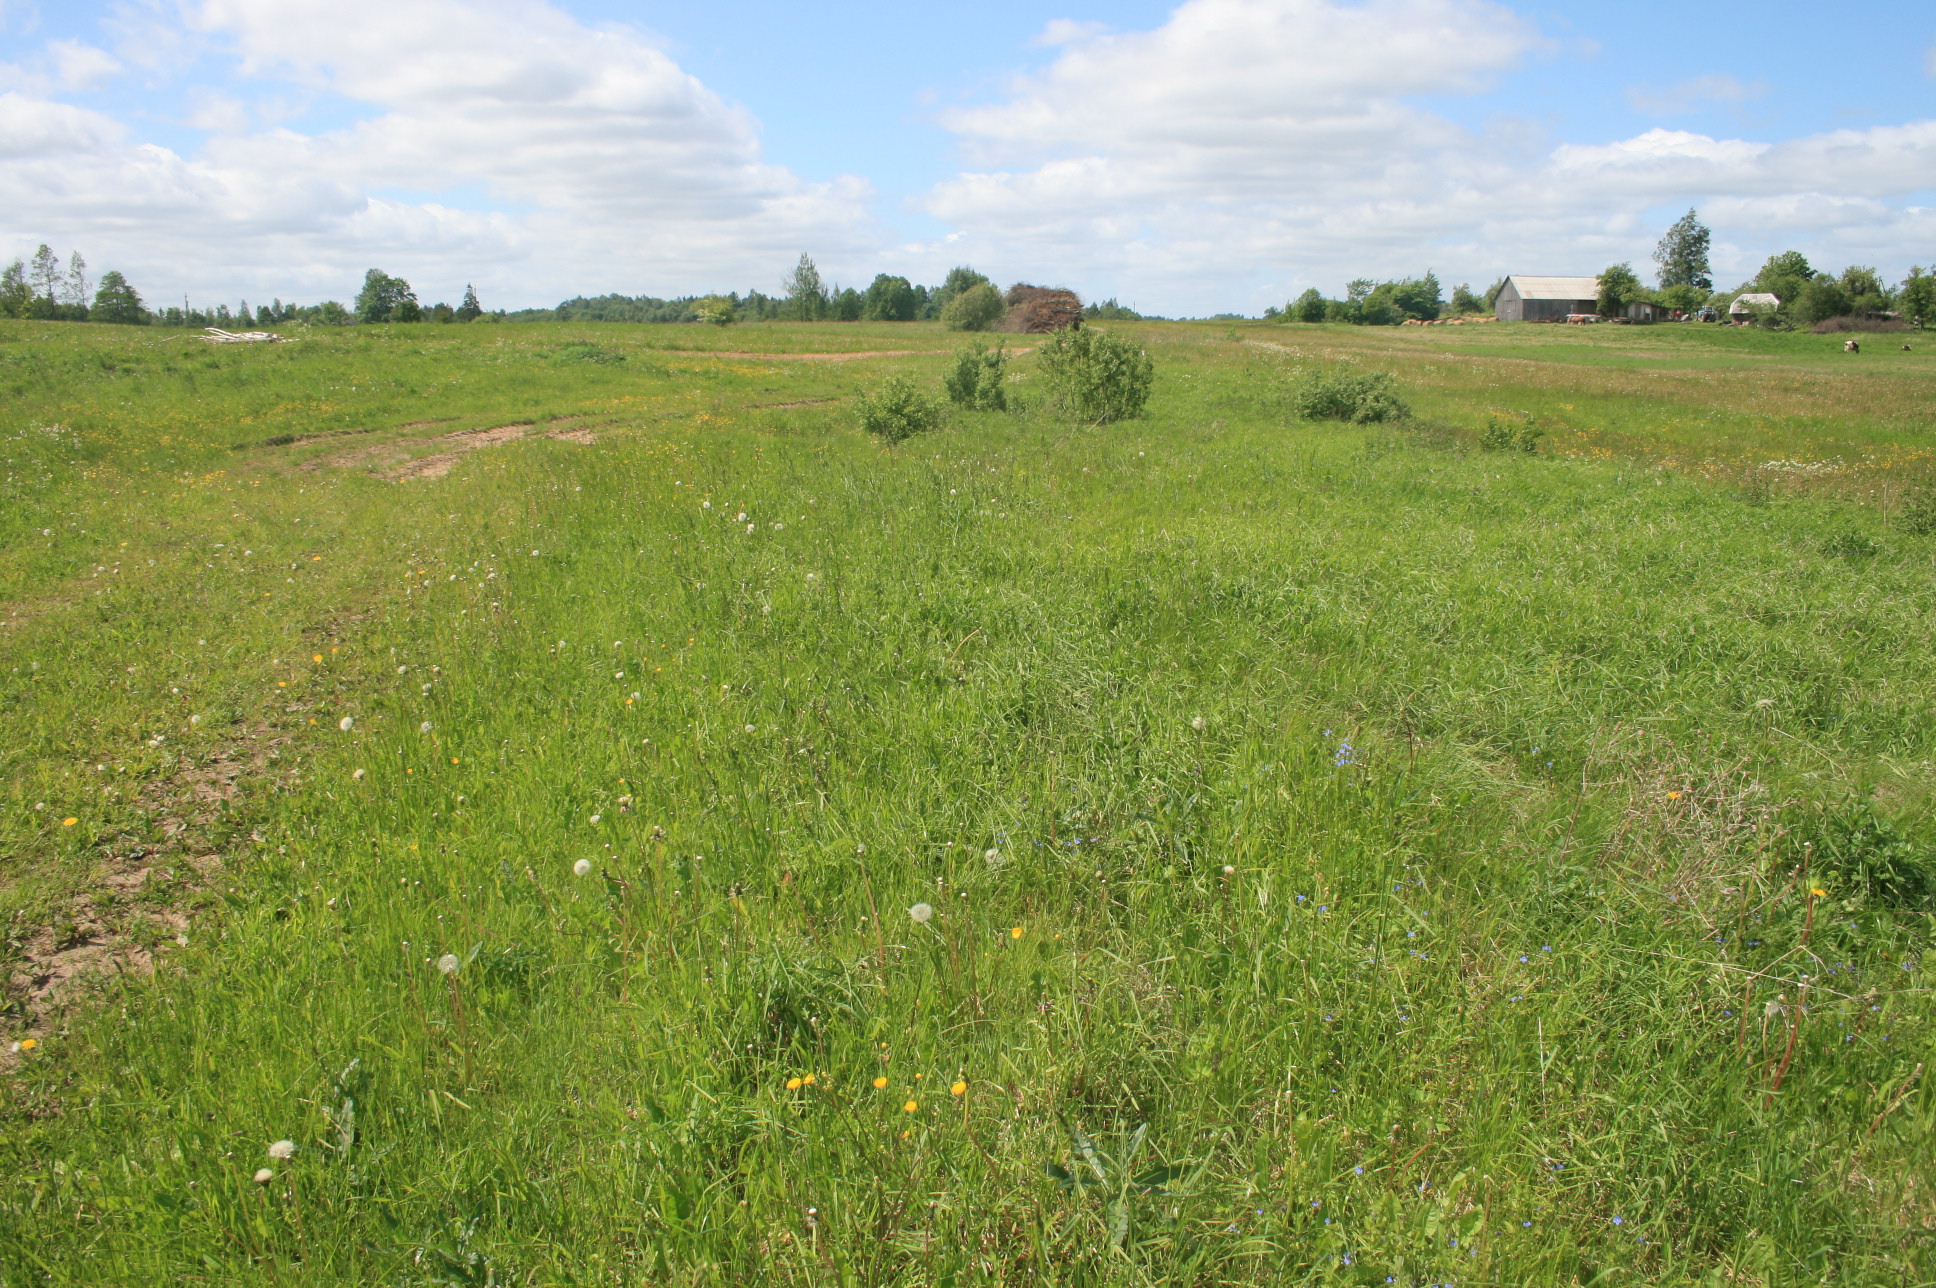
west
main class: Grassland
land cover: Grassland without tree/shrub cover
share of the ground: > 75 %
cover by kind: herbaceous plants 95 %, unconsolidated bare surface 5 %
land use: Agriculture (excluding fallow land and kitchen gardens)
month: June
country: LT
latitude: 56.0948
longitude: 22.3859
